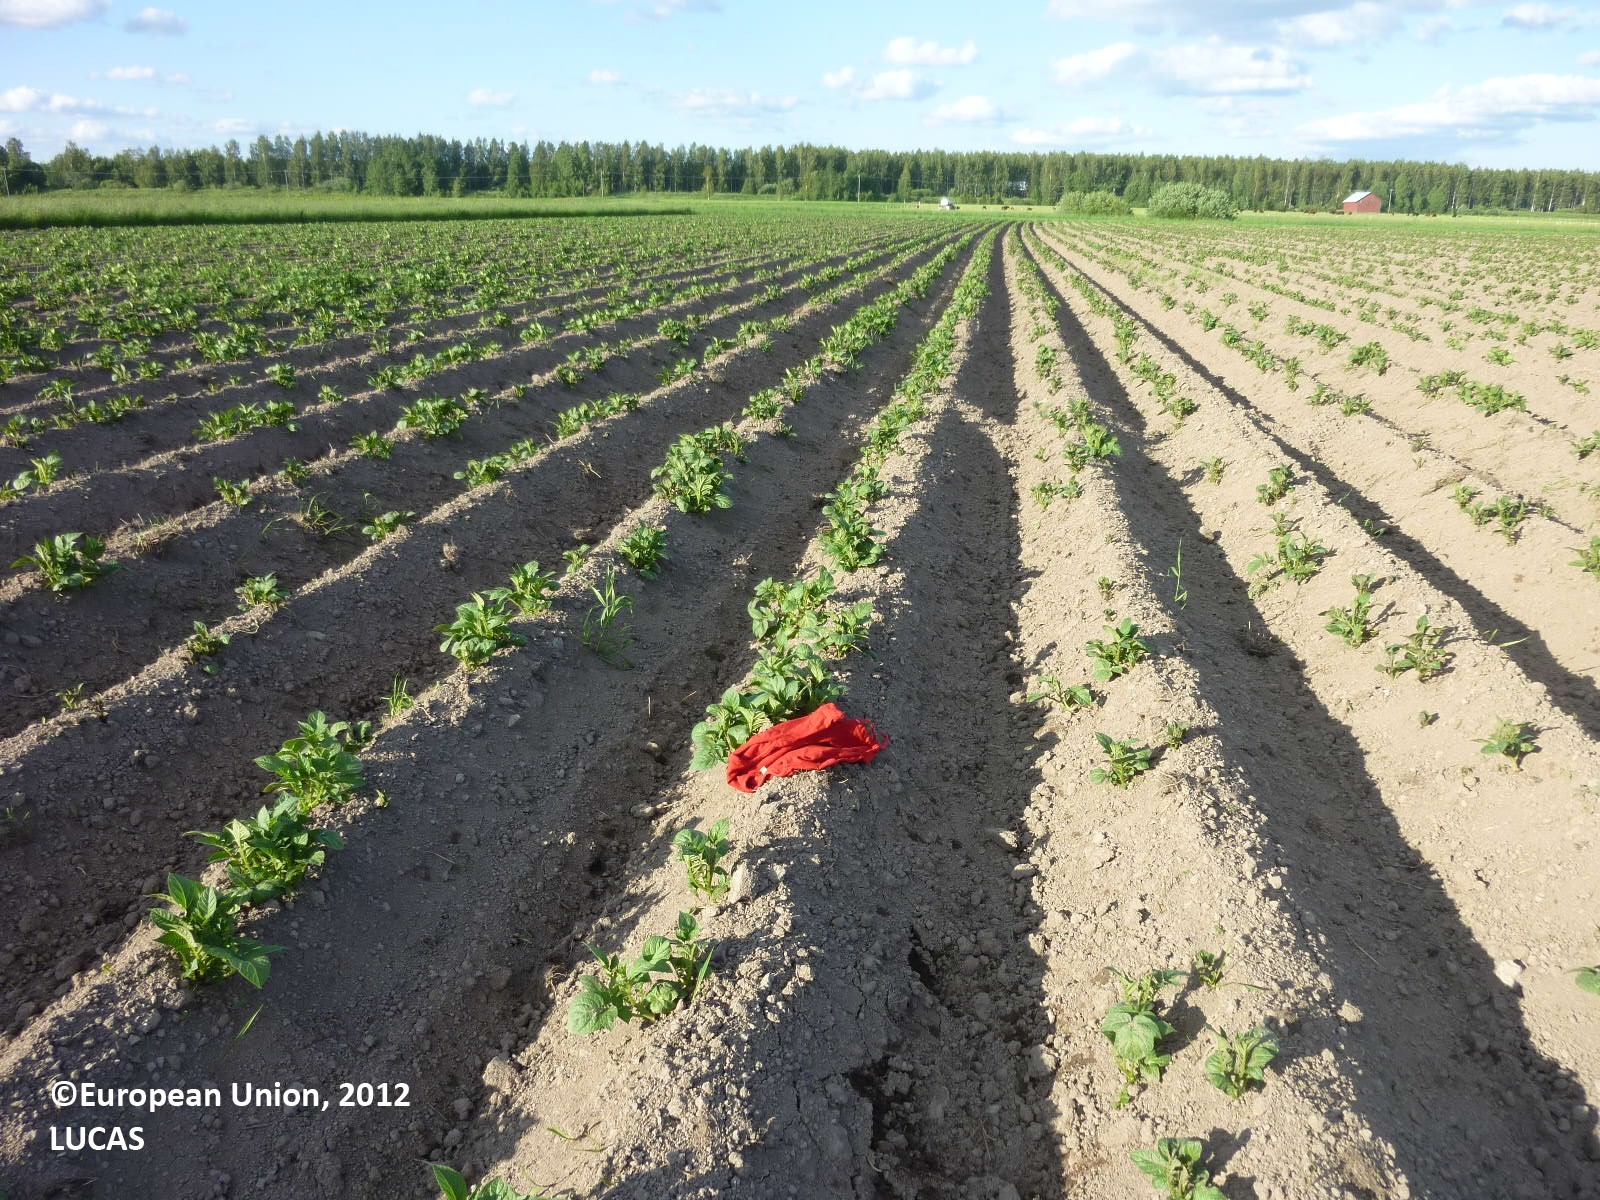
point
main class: Cropland
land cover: Potatoes
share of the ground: 10 - 25 %
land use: Agriculture (excluding fallow land and kitchen gardens)
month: July
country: FI
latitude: 61.2065
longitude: 22.5548
